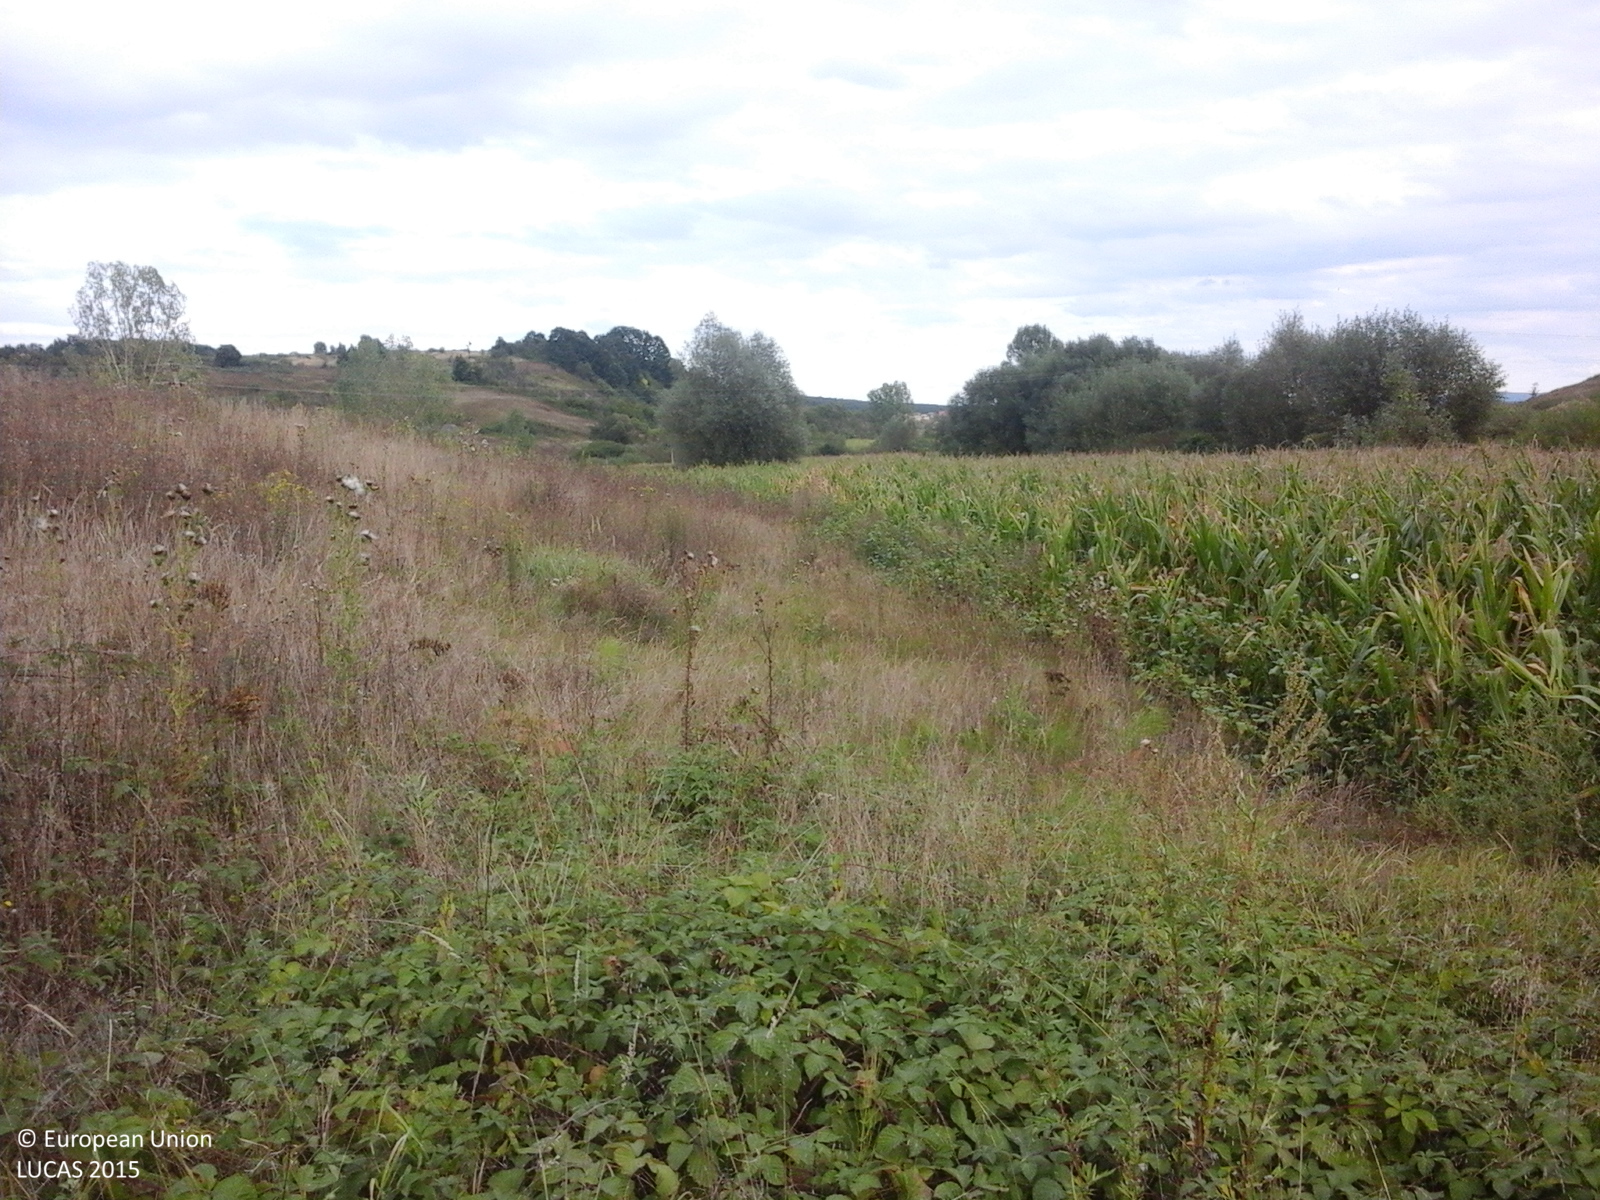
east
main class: Grassland
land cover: Spontaneously vegetated surfaces
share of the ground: > 75 %
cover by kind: herbaceous plants 100 %
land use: Fallow land
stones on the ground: < 10 %
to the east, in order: Spontaneously vegetated surfaces; Maize; Electric lines; Maize; Single bushes/trees; Maize
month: September
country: RO
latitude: 47.4939
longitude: 23.0880
